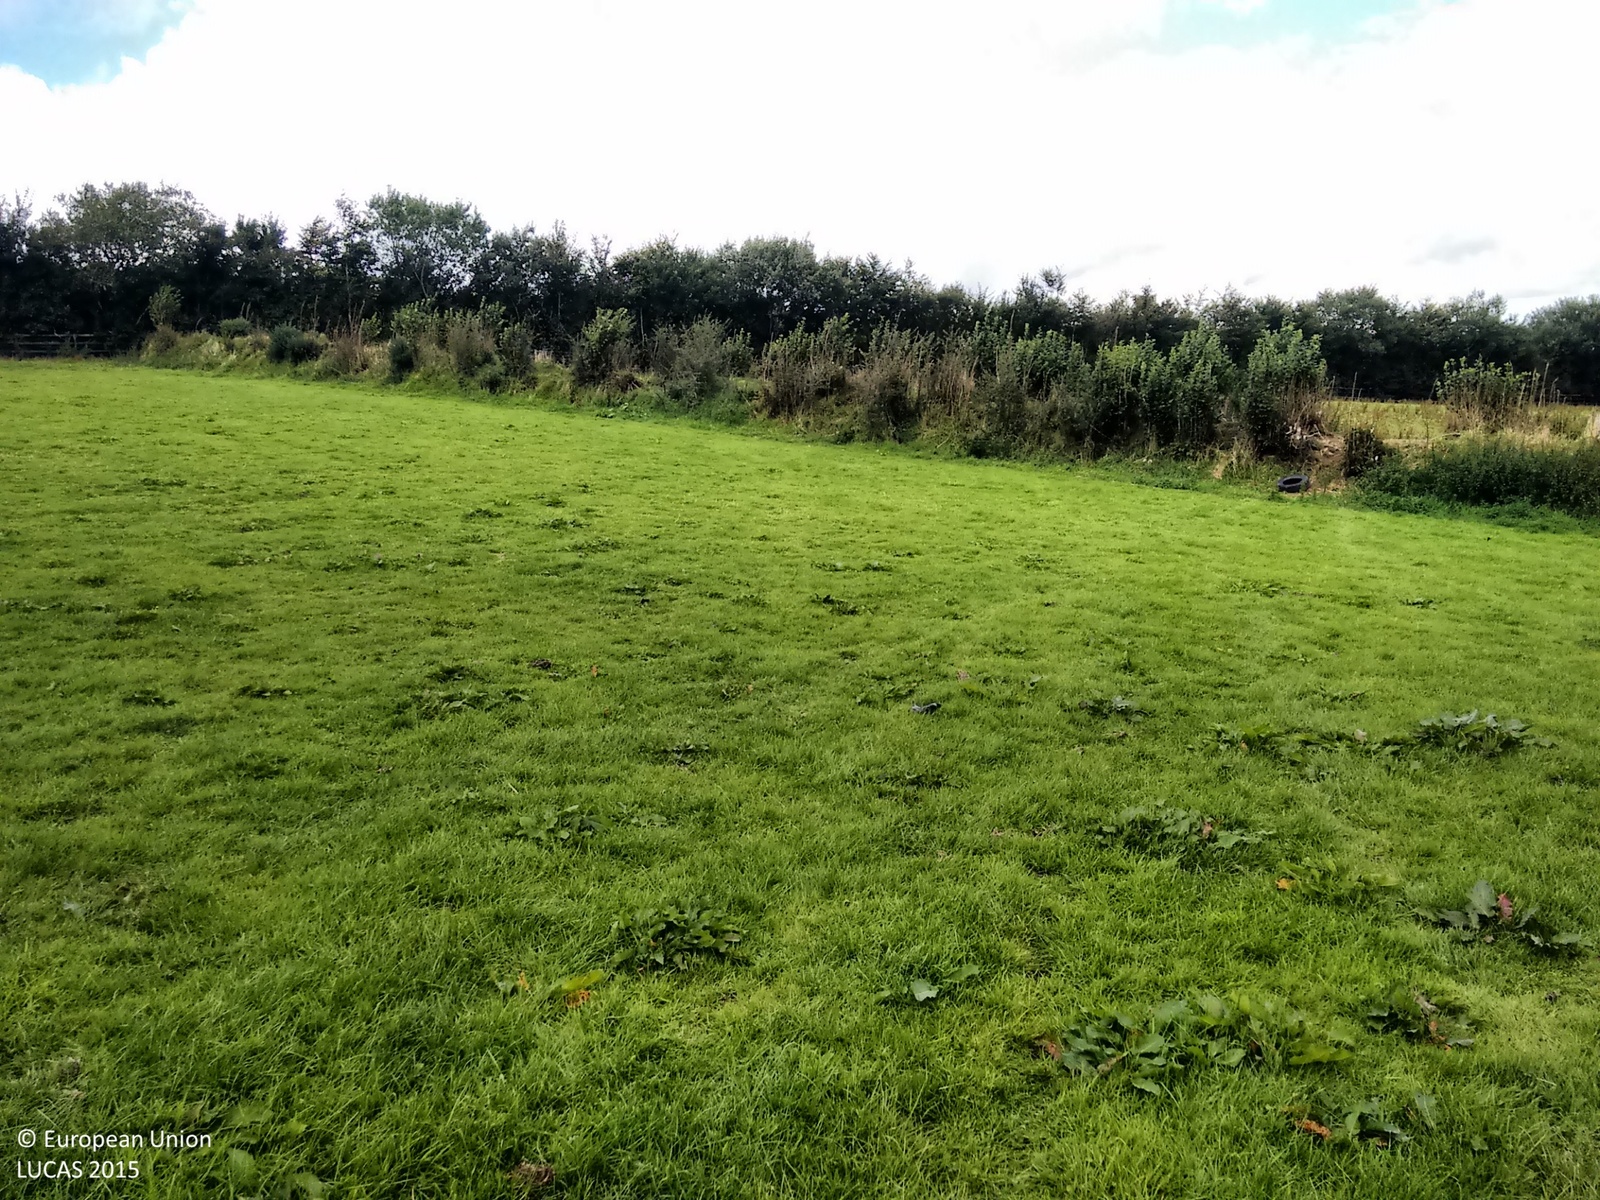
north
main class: Grassland
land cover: Grassland without tree/shrub cover
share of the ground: > 75 %
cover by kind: herbaceous plants 100 %
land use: Agriculture (excluding fallow land and kitchen gardens)
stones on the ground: < 10 %
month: September
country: GB
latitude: 50.7151
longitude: -4.0454
